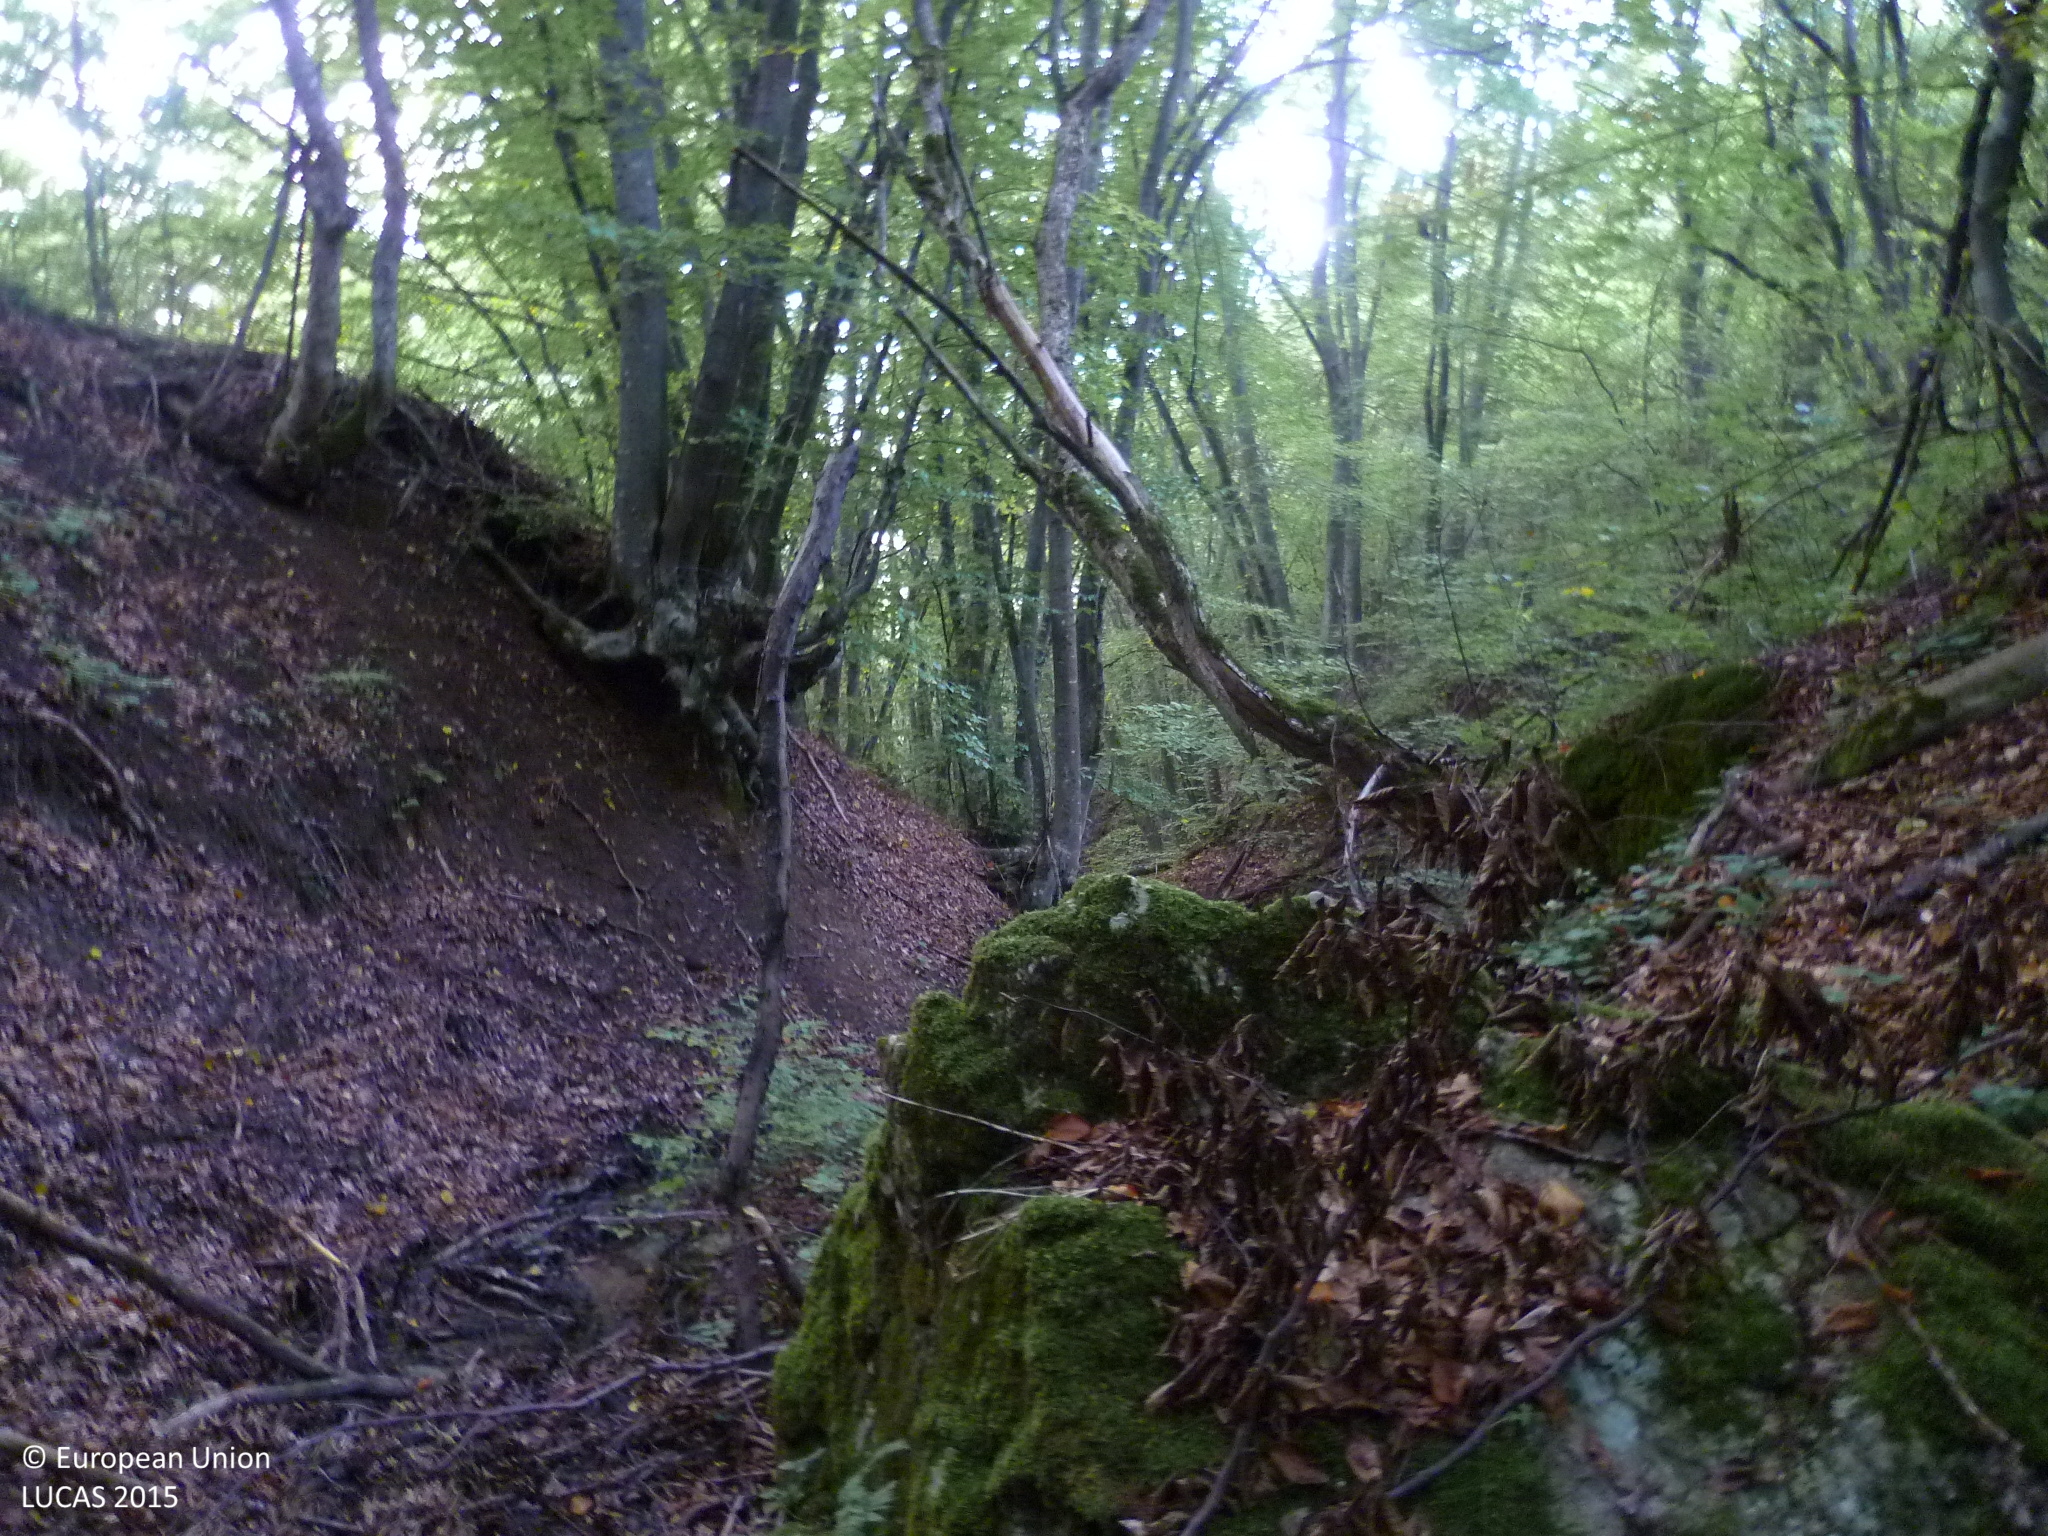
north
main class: Woodland
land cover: Broadleaved woodland
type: beech forest
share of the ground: 50 - 75 %
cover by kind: broadleaved forest trees 70 %, unconsolidated bare surface 20 %, lichens and mosses 10 %
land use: Forestry
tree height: > 5 m
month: October
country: BG
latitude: 42.8559
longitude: 22.6937
